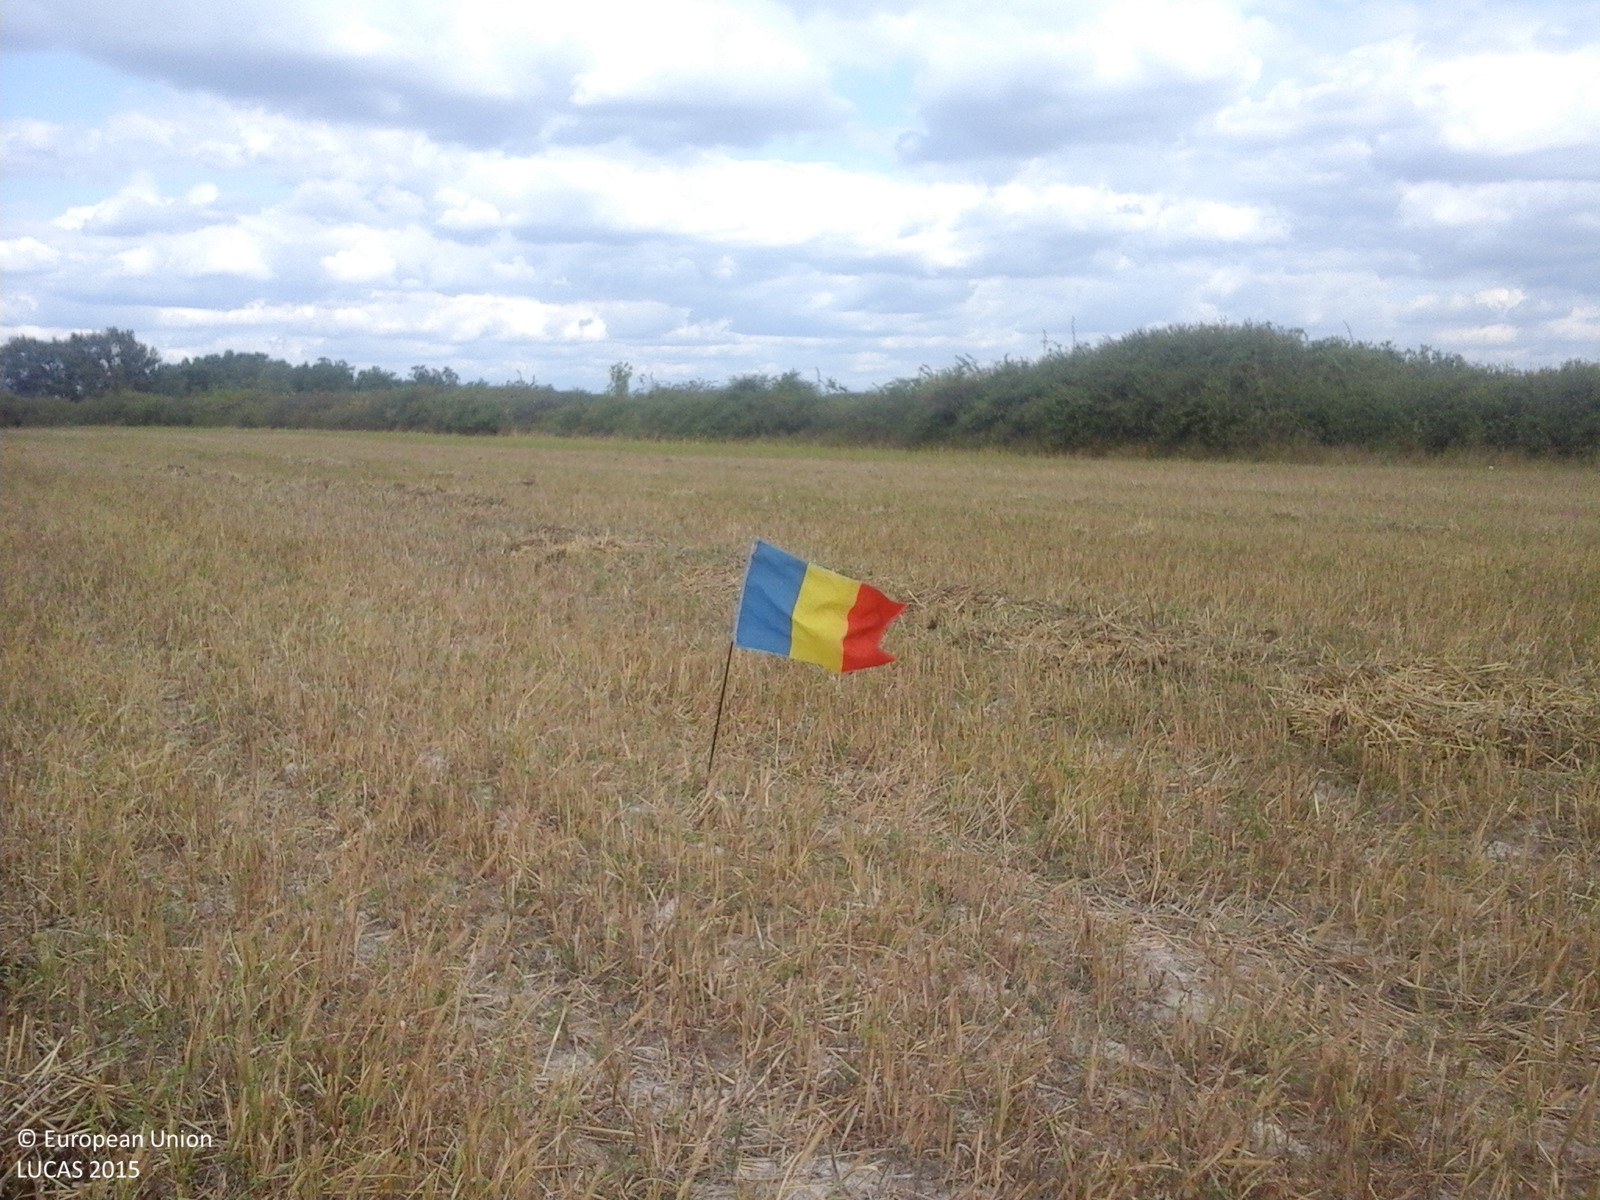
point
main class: Cropland
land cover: Common wheat
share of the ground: > 75 %
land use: Agriculture (excluding fallow land and kitchen gardens)
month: September
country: RO
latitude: 47.9061
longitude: 22.8409
